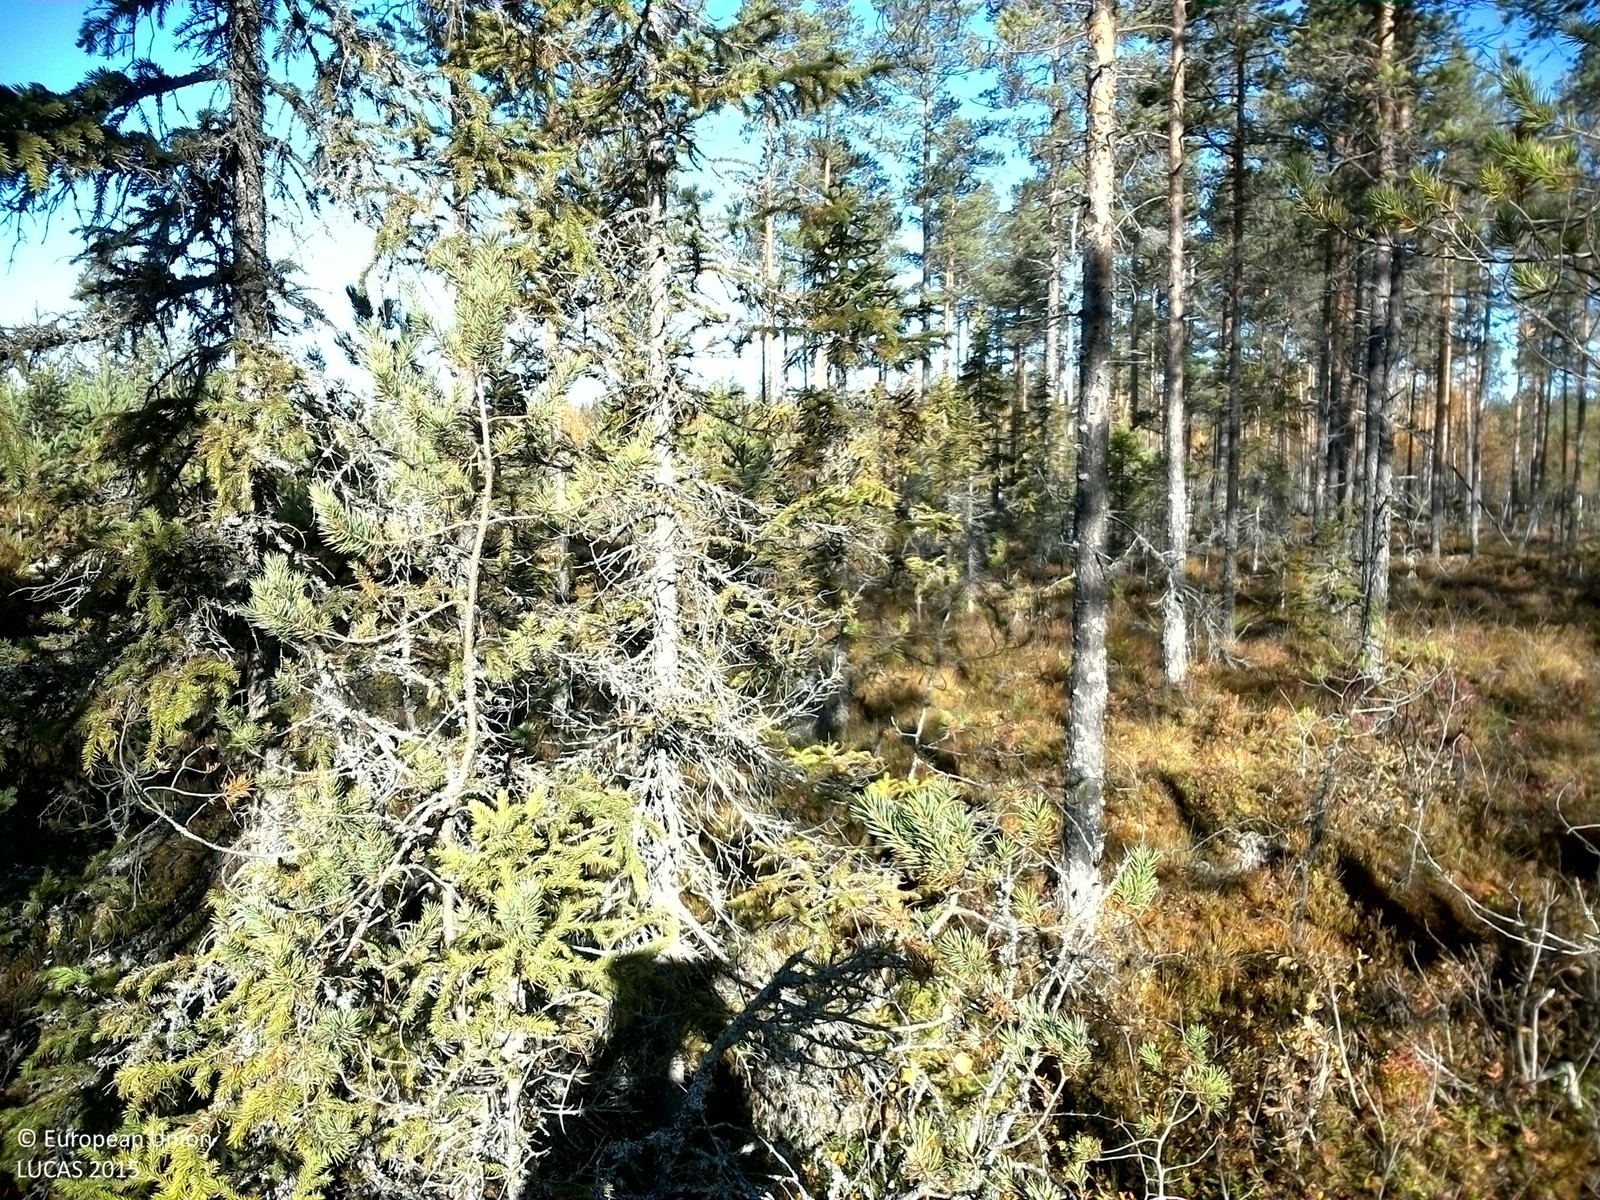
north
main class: Woodland
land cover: Pine dominated coniferous woodland
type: boreal forest
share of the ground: 50 - 75 %
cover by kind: coniferous forest trees 50 %, shrubs 30 %, lichens and mosses 15 %, herbaceous plants 5 %
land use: Forestry
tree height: > 5 m
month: October
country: SE
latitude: 61.1828
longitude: 15.2856
